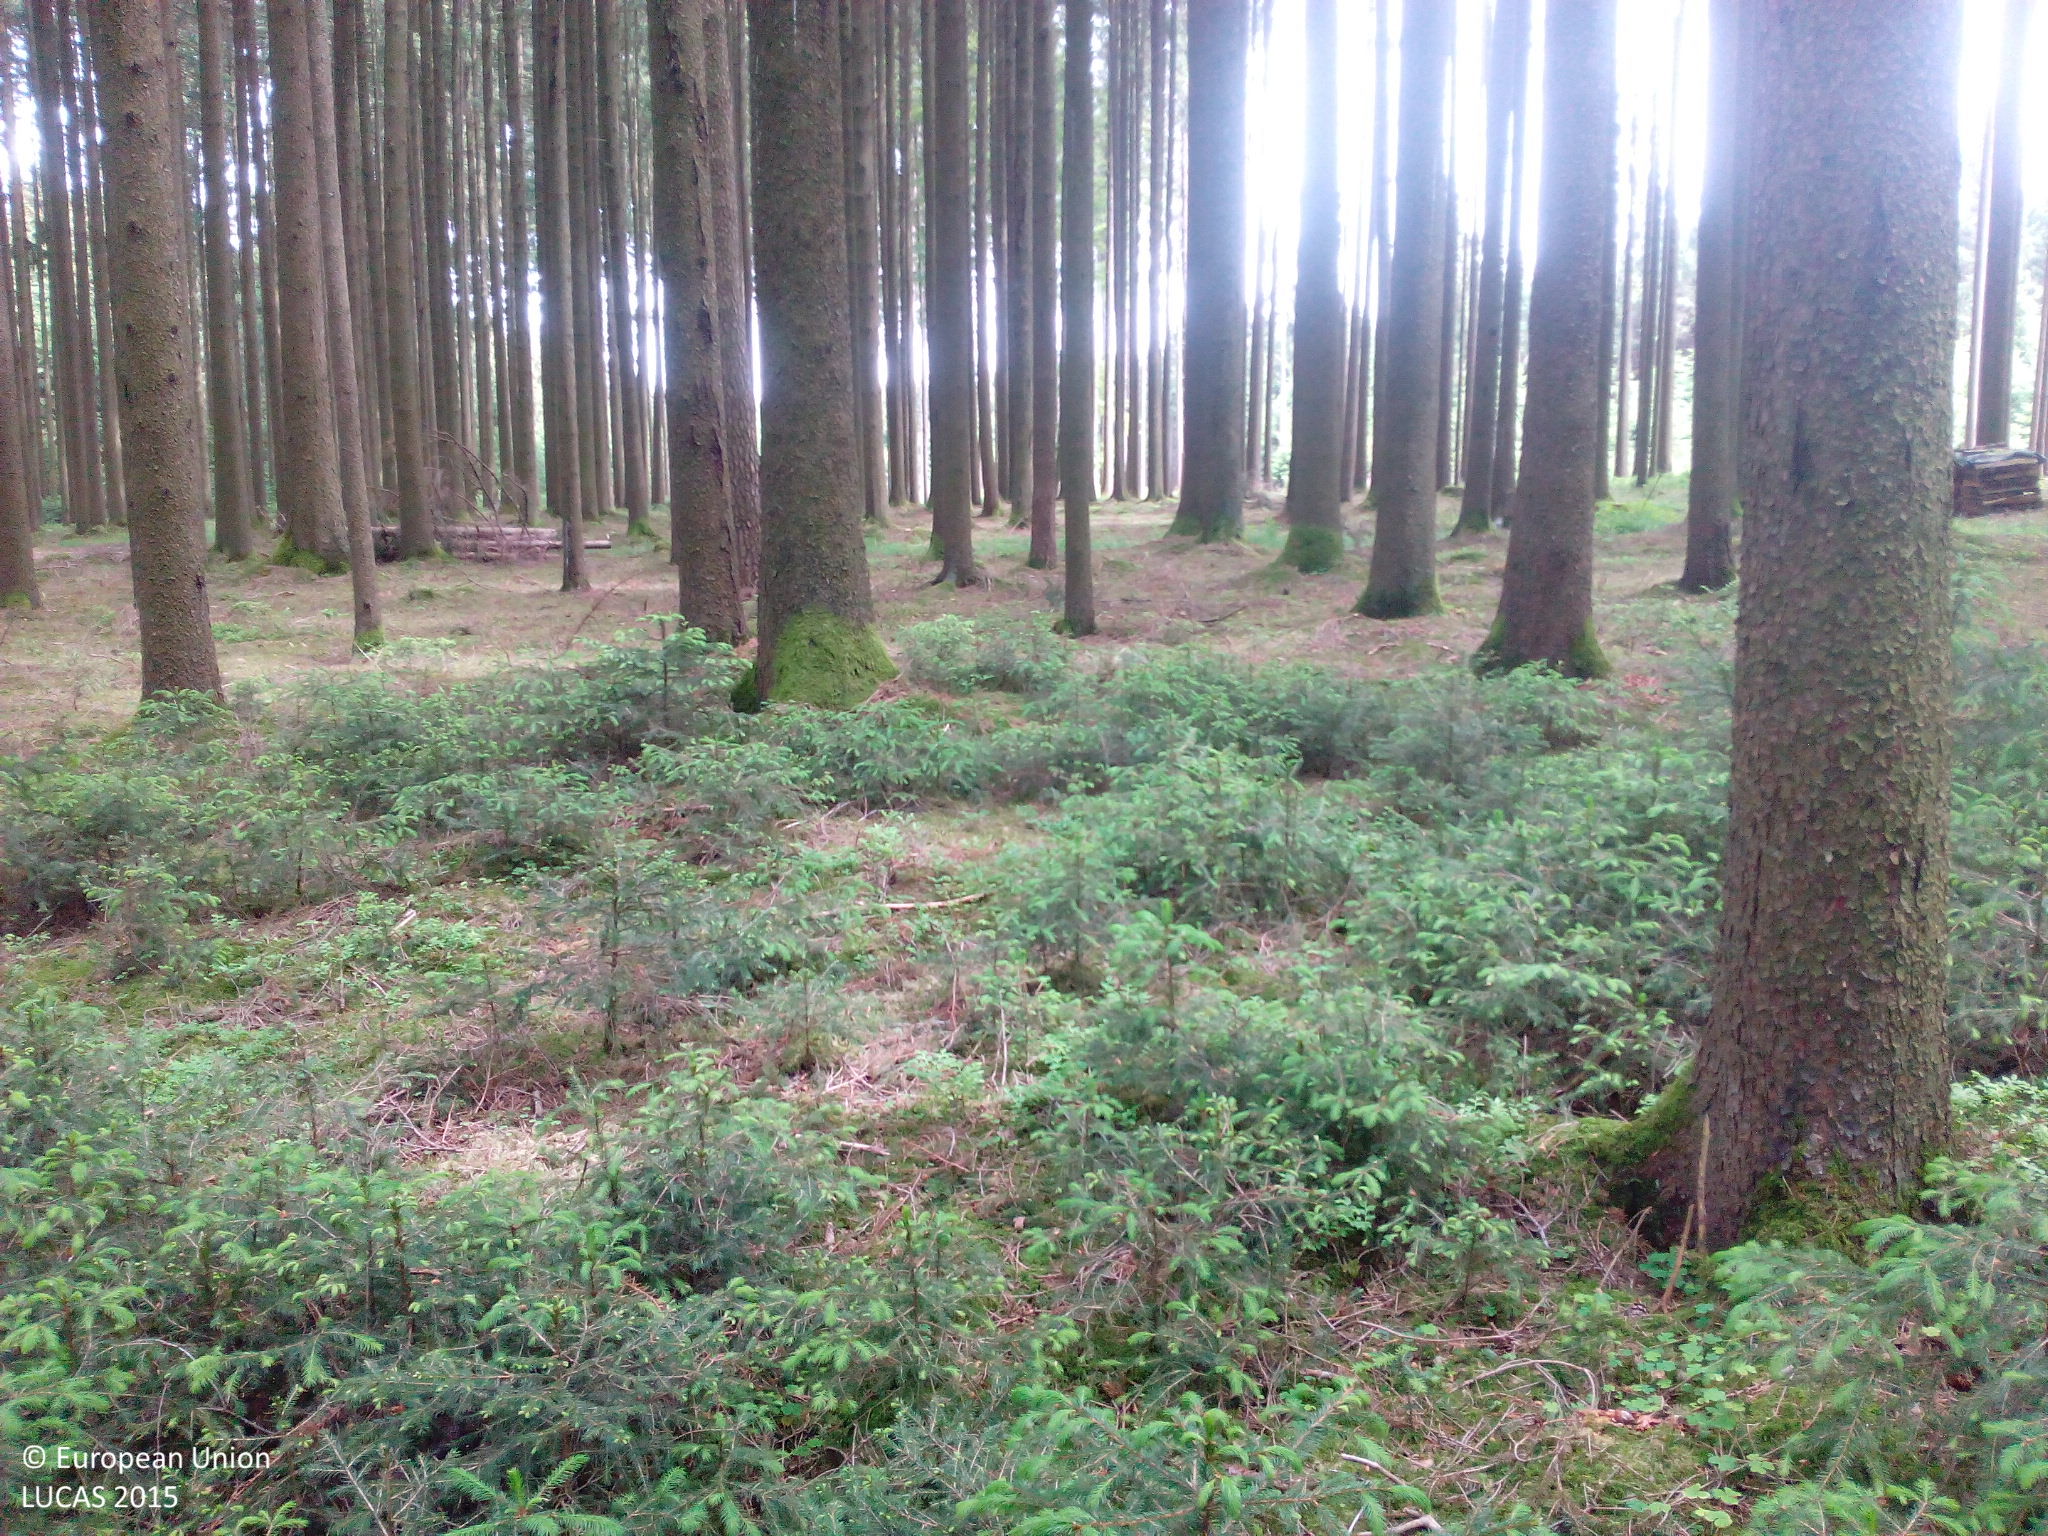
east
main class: Woodland
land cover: Spruce dominated coniferous woodland
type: hemiboreal forest and nemoral coniferous forest and mixed broadleaved-coniferous forest
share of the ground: > 75 %
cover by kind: coniferous forest trees 100 %
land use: Forestry
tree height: > 5 m
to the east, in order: Spruce dominated coniferous woodland; Tracks; Spruce dominated coniferous woodland; Shrubland with sparse tree cover; Tracks; Shrubland with sparse tree cover; Spruce dominated coniferous woodland
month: May
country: DE
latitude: 48.0613
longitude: 10.2548
